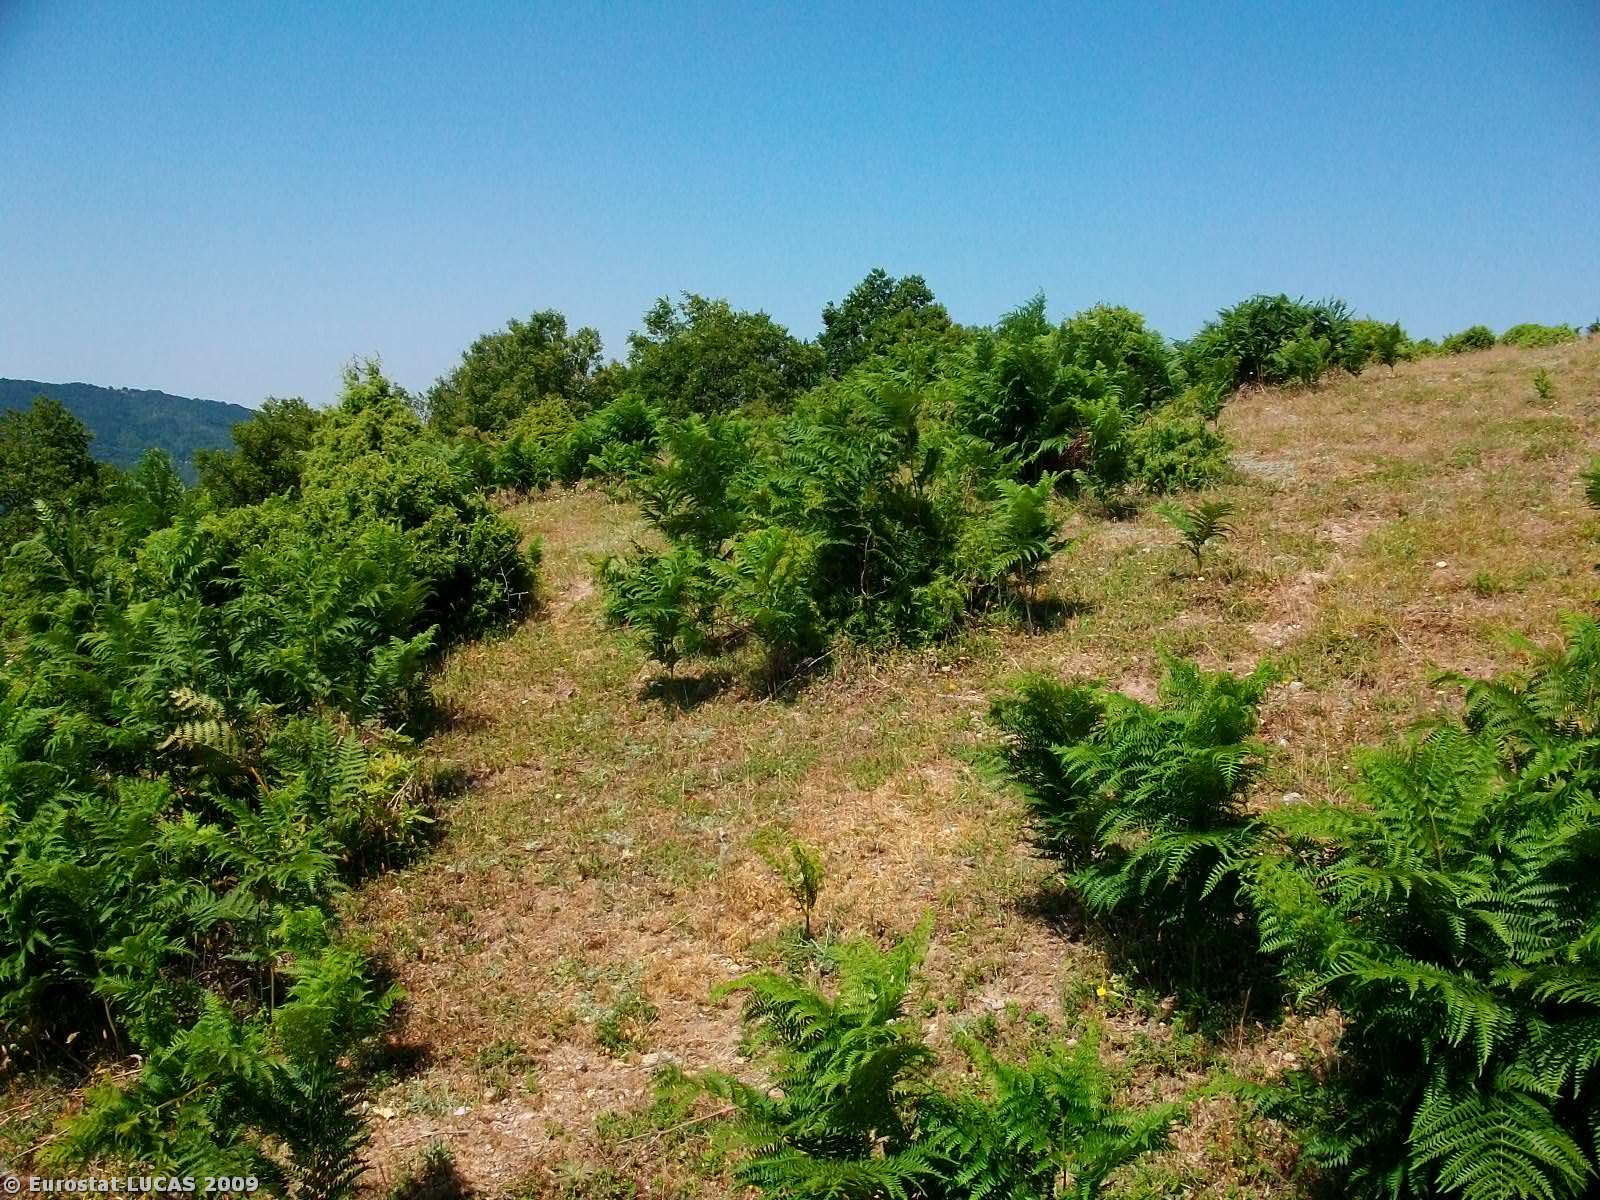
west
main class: Shrubland
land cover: Shrubland without tree cover
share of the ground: > 75 %
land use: Agriculture (excluding fallow land and kitchen gardens)
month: June
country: GR
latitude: 41.2108
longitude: 25.8636
